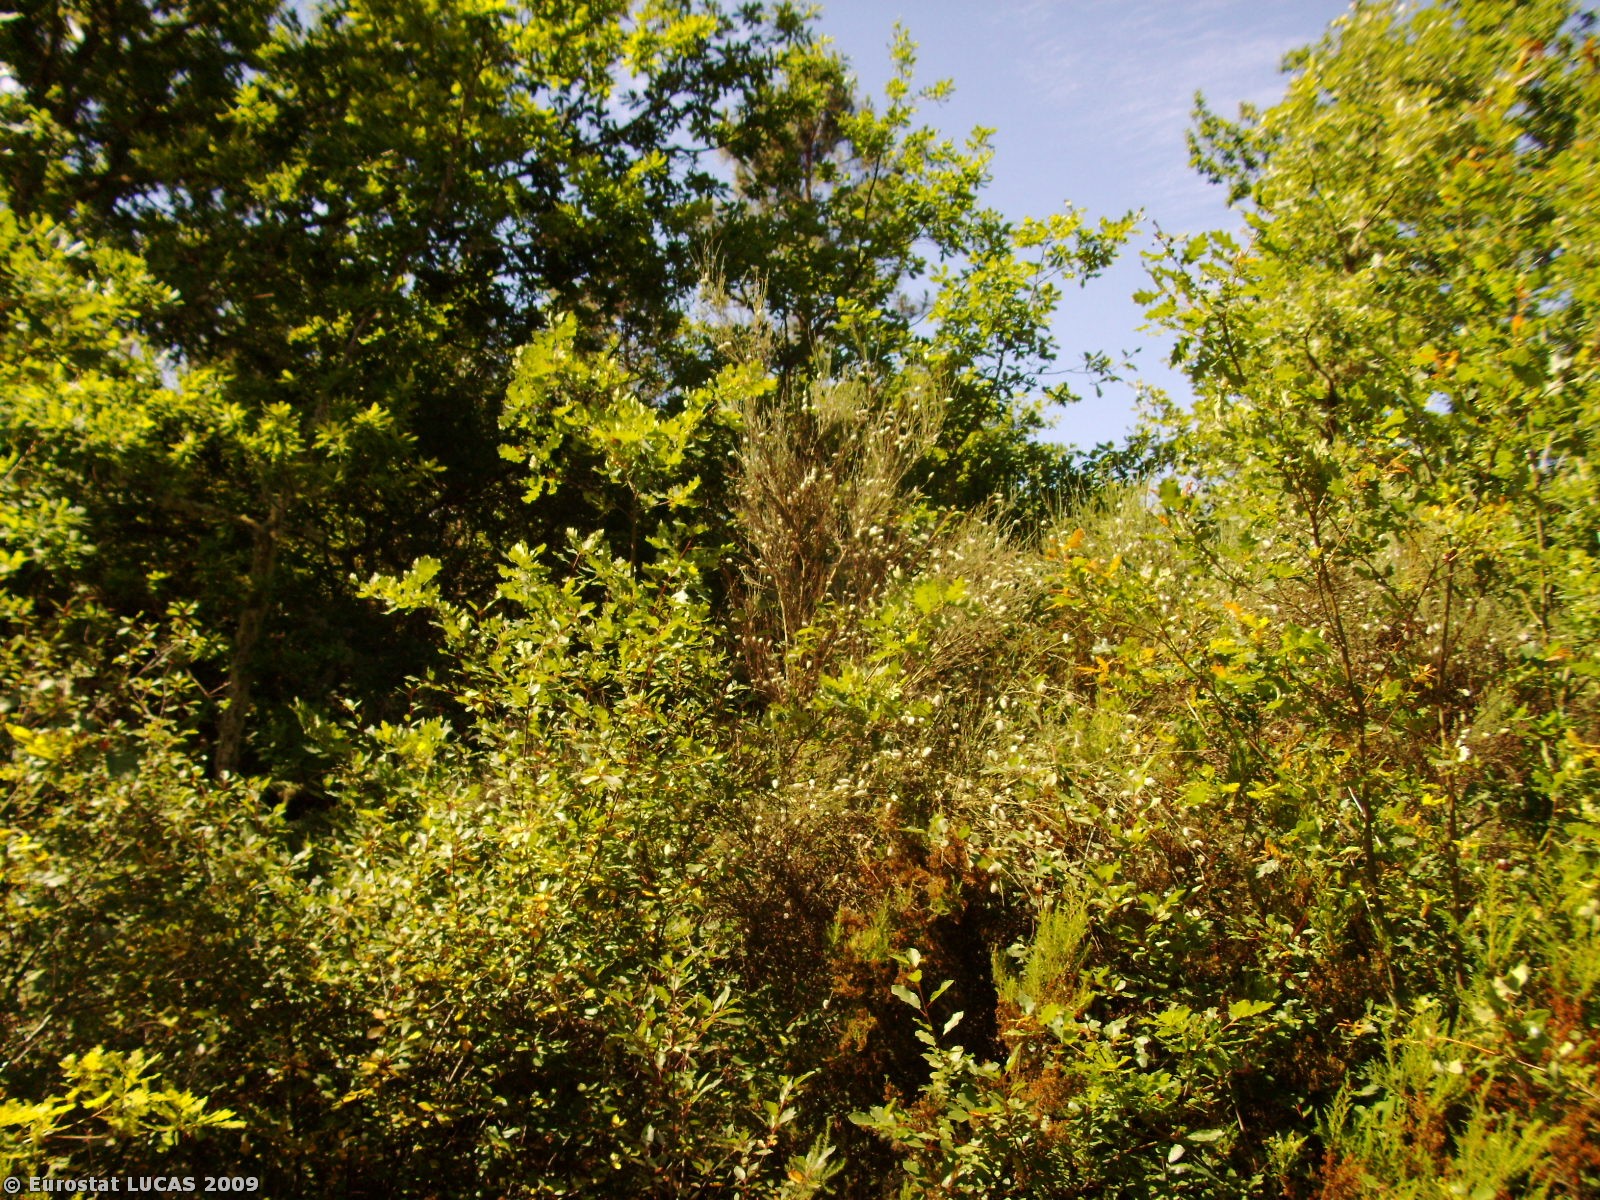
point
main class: Woodland
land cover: Broadleaved woodland
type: mesophytic deciduous forest
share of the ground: > 75 %
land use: Forestry
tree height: > 5 m
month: July
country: PT
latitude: 40.8430
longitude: -7.6868
